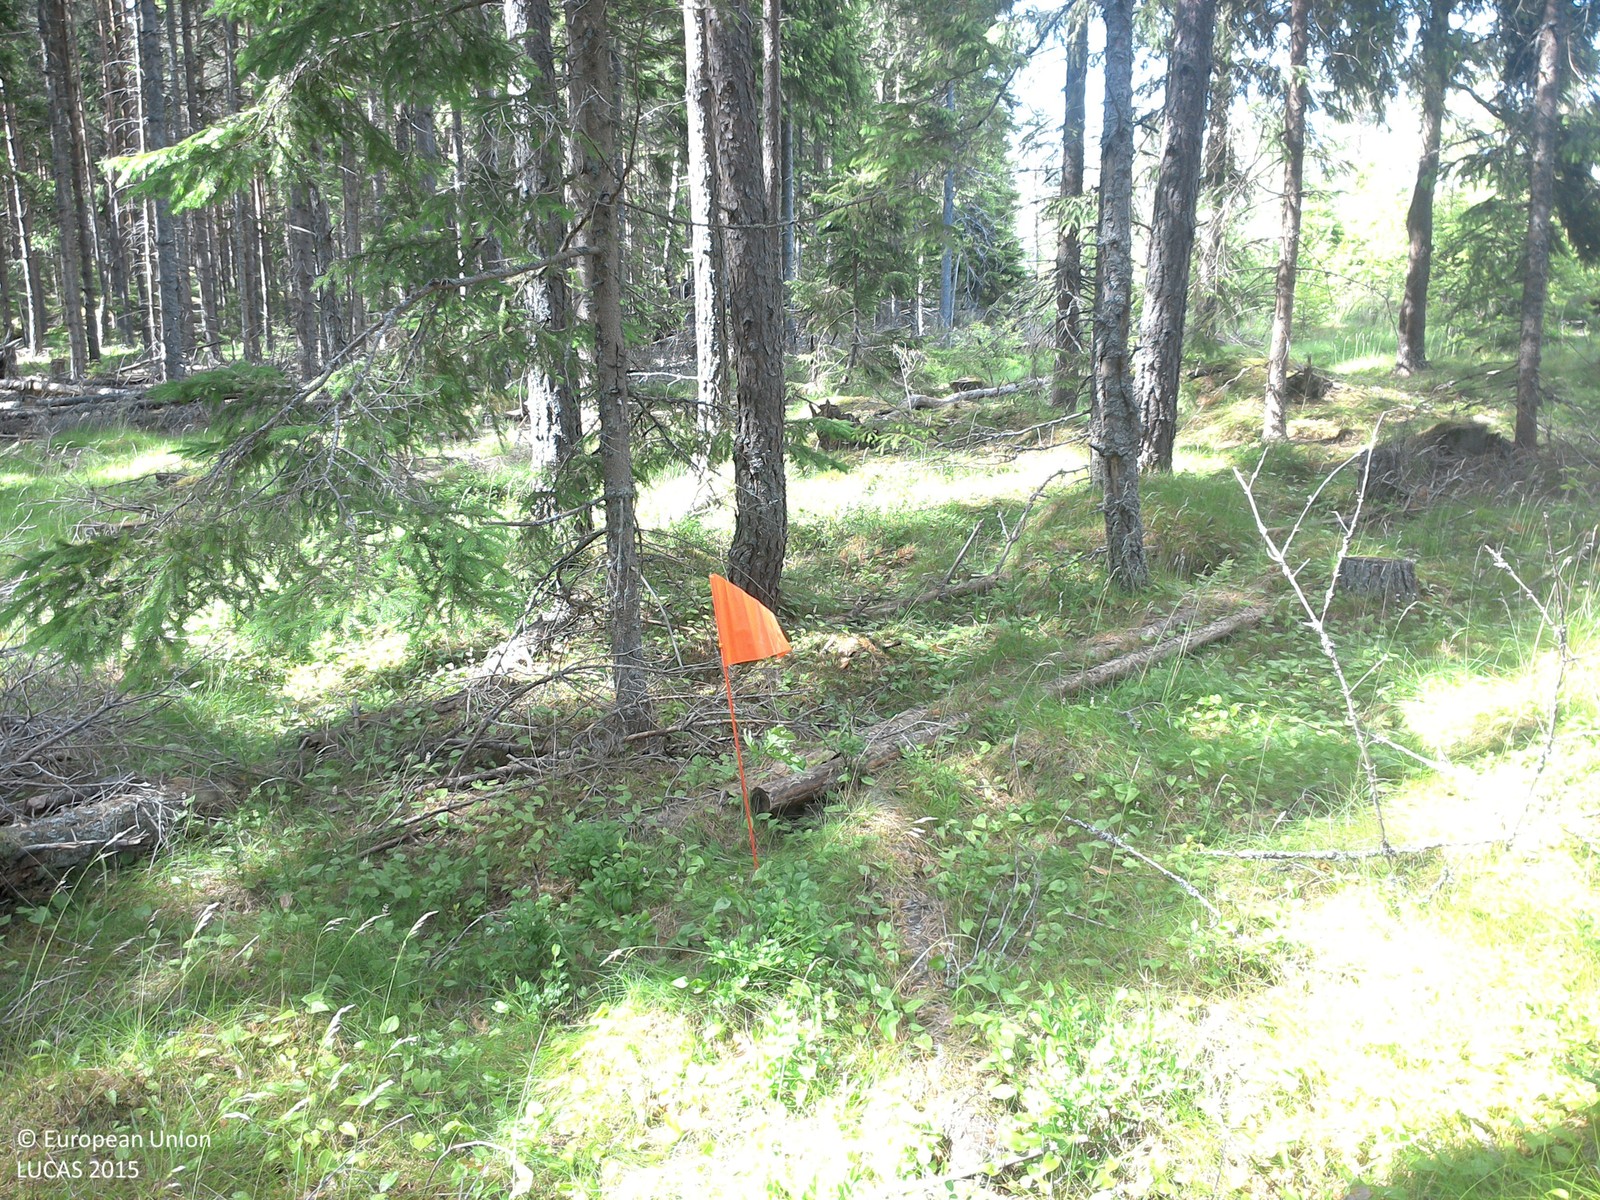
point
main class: Woodland
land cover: Pine dominated coniferous woodland
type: boreal forest
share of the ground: 50 - 75 %
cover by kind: coniferous forest trees 65 %, lichens and mosses 30 %, herbaceous plants 5 %
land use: Forestry
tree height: > 5 m
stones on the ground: < 10 %
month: June
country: SE
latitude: 58.0528
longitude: 15.5023
